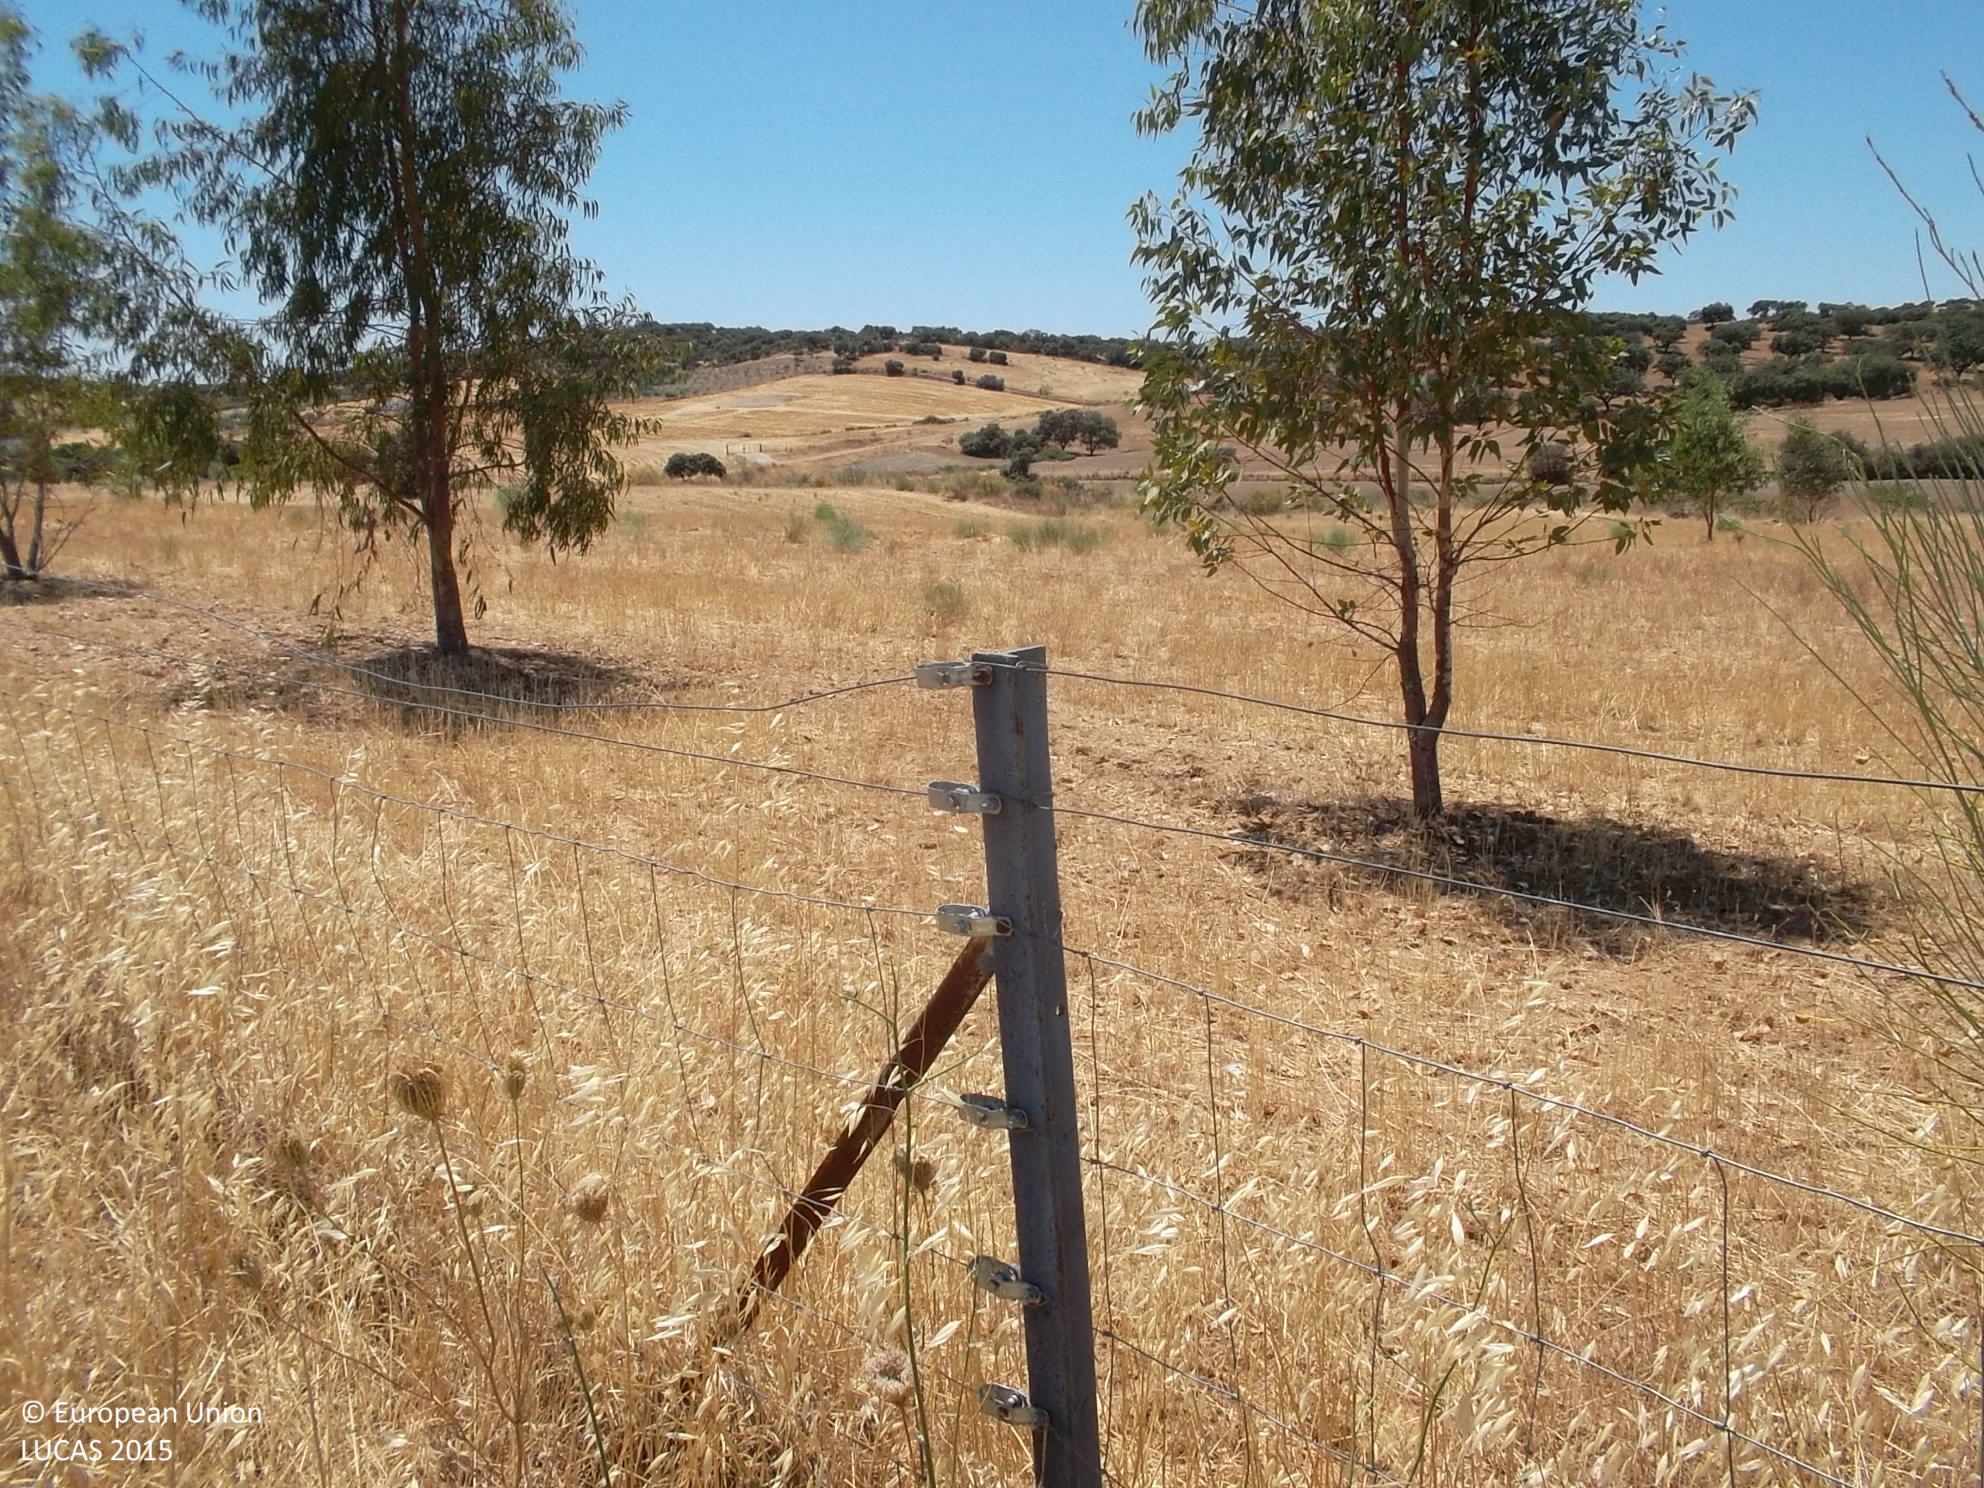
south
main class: Cropland
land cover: Mixed cereals for fodder
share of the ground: < 10 %
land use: Agriculture (excluding fallow land and kitchen gardens)
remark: Harvested field
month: July
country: ES
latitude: 38.2225
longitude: -5.6943
